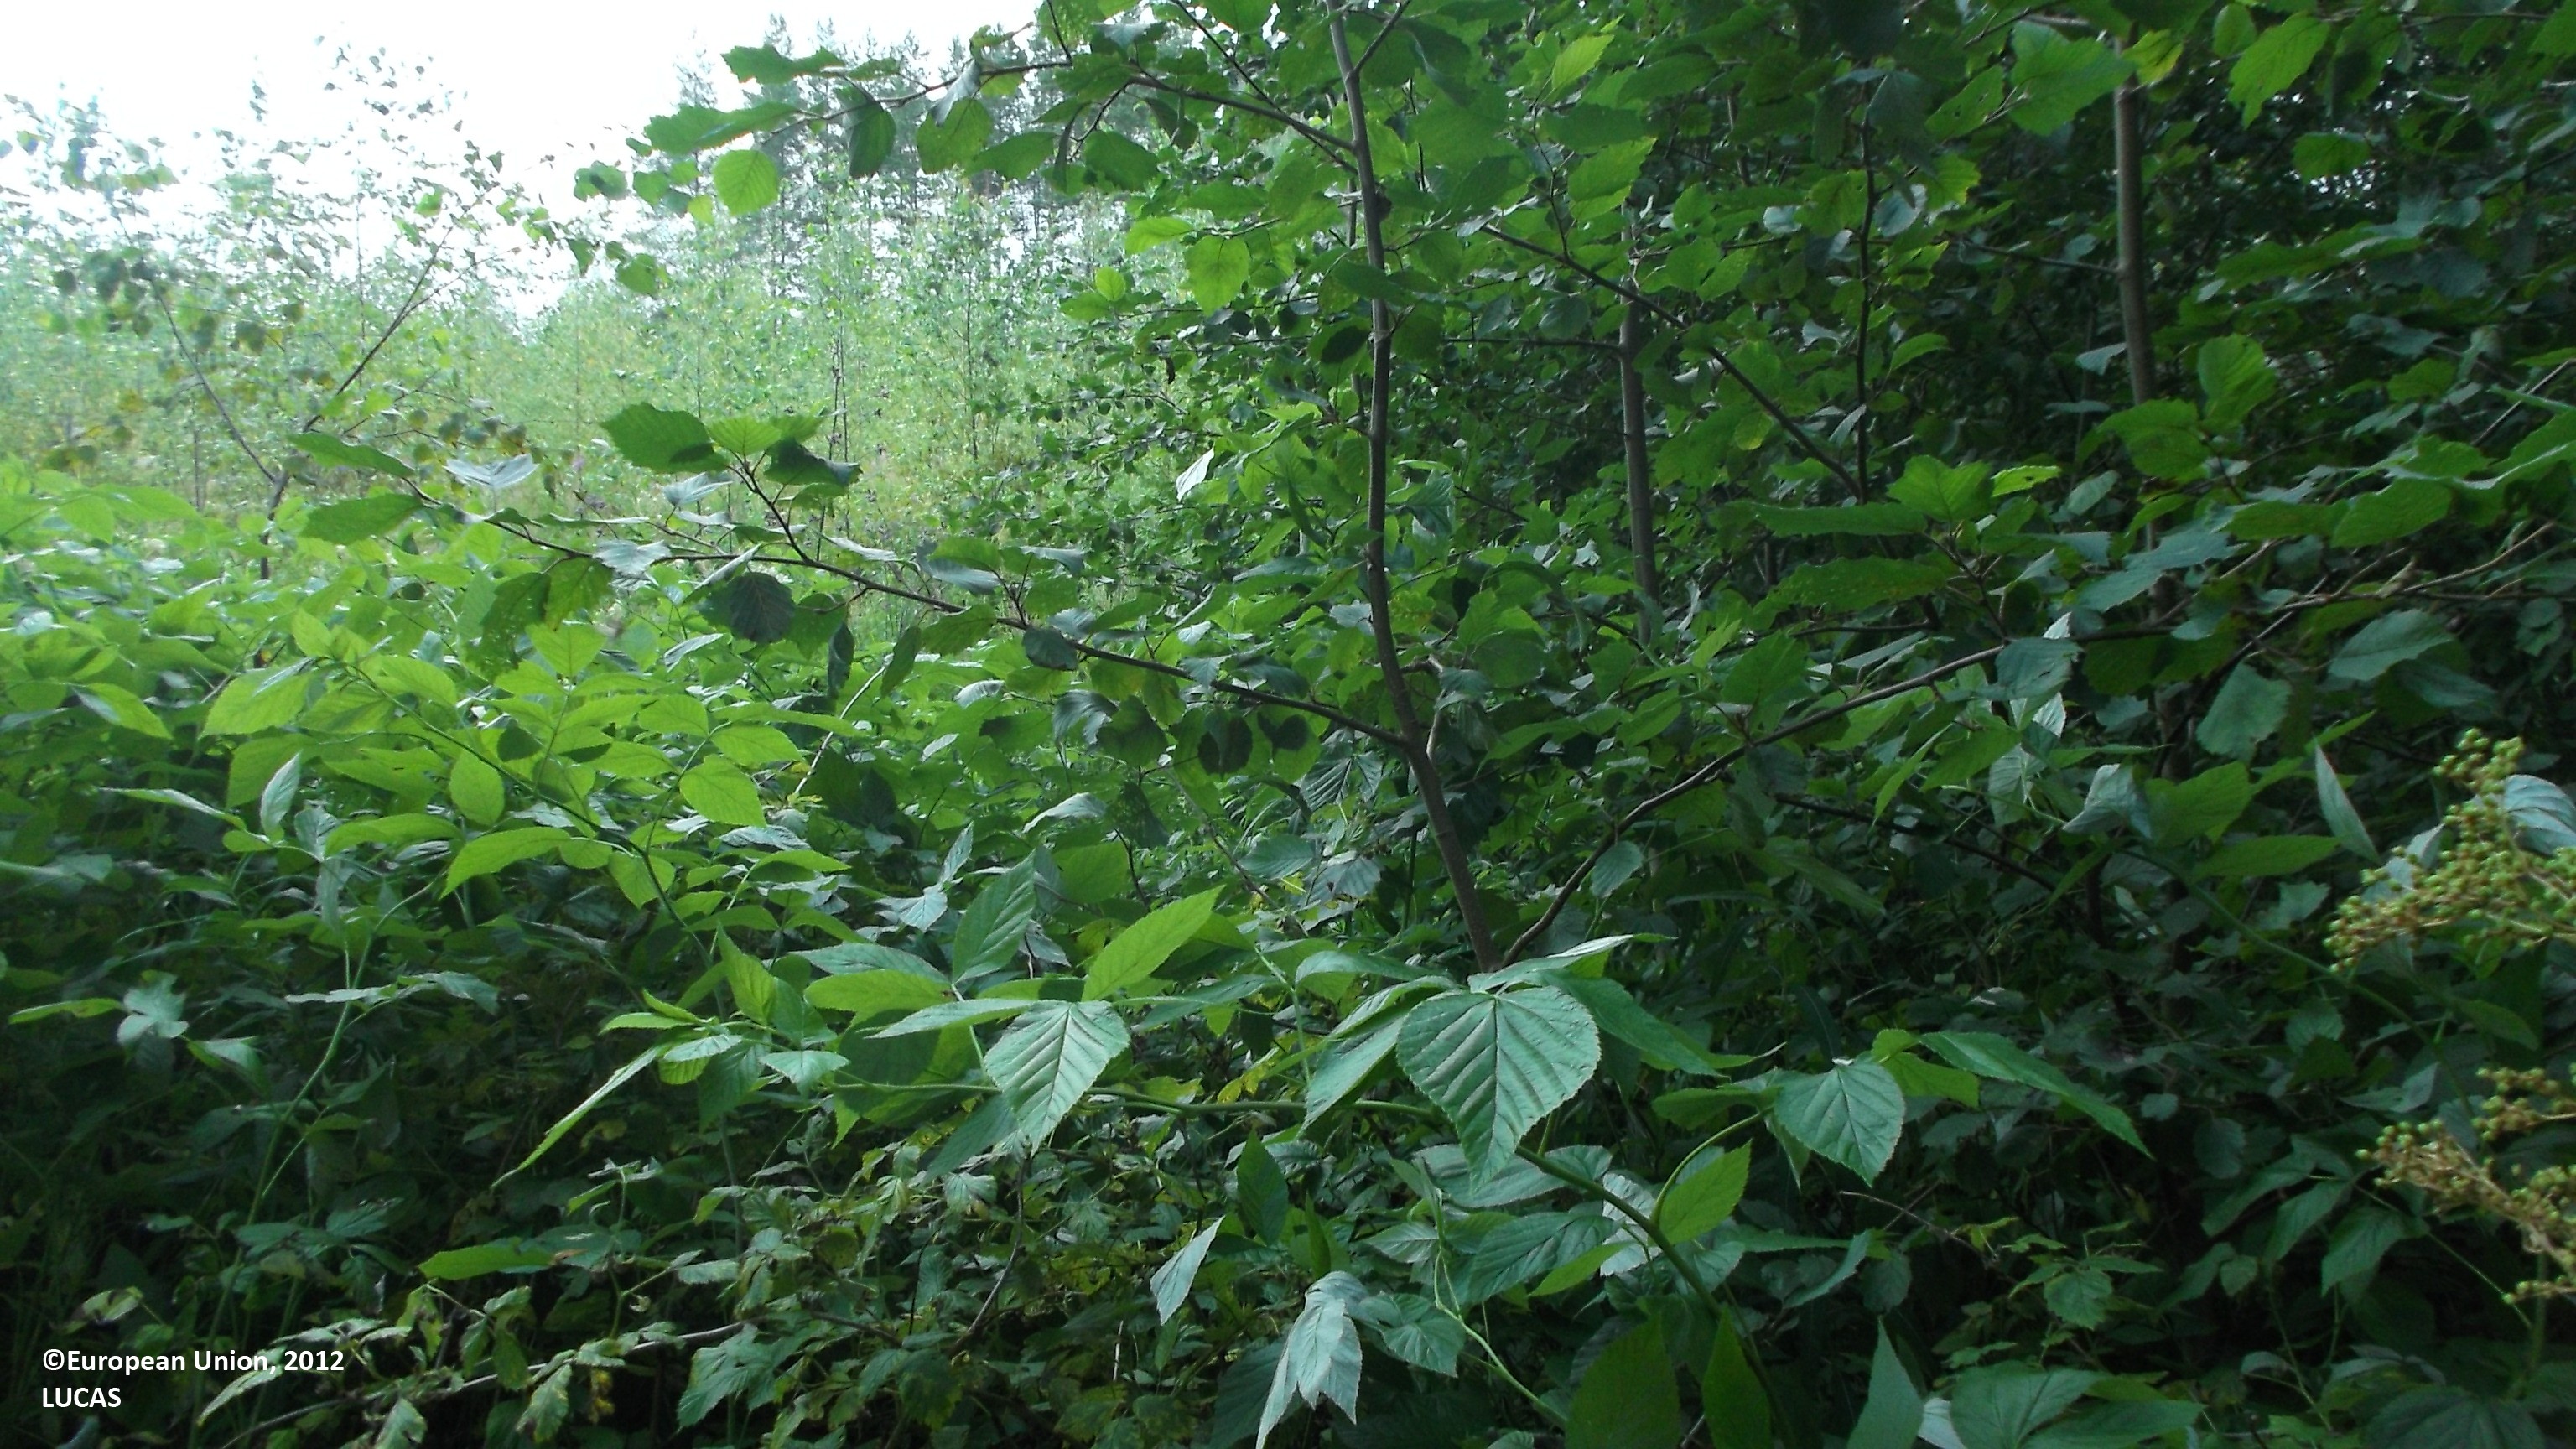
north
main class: Shrubland
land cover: Shrubland with sparse tree cover
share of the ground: 25 - 50 %
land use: Forestry
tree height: > 5 m
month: August
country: FI
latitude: 63.0745
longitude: 24.3932
